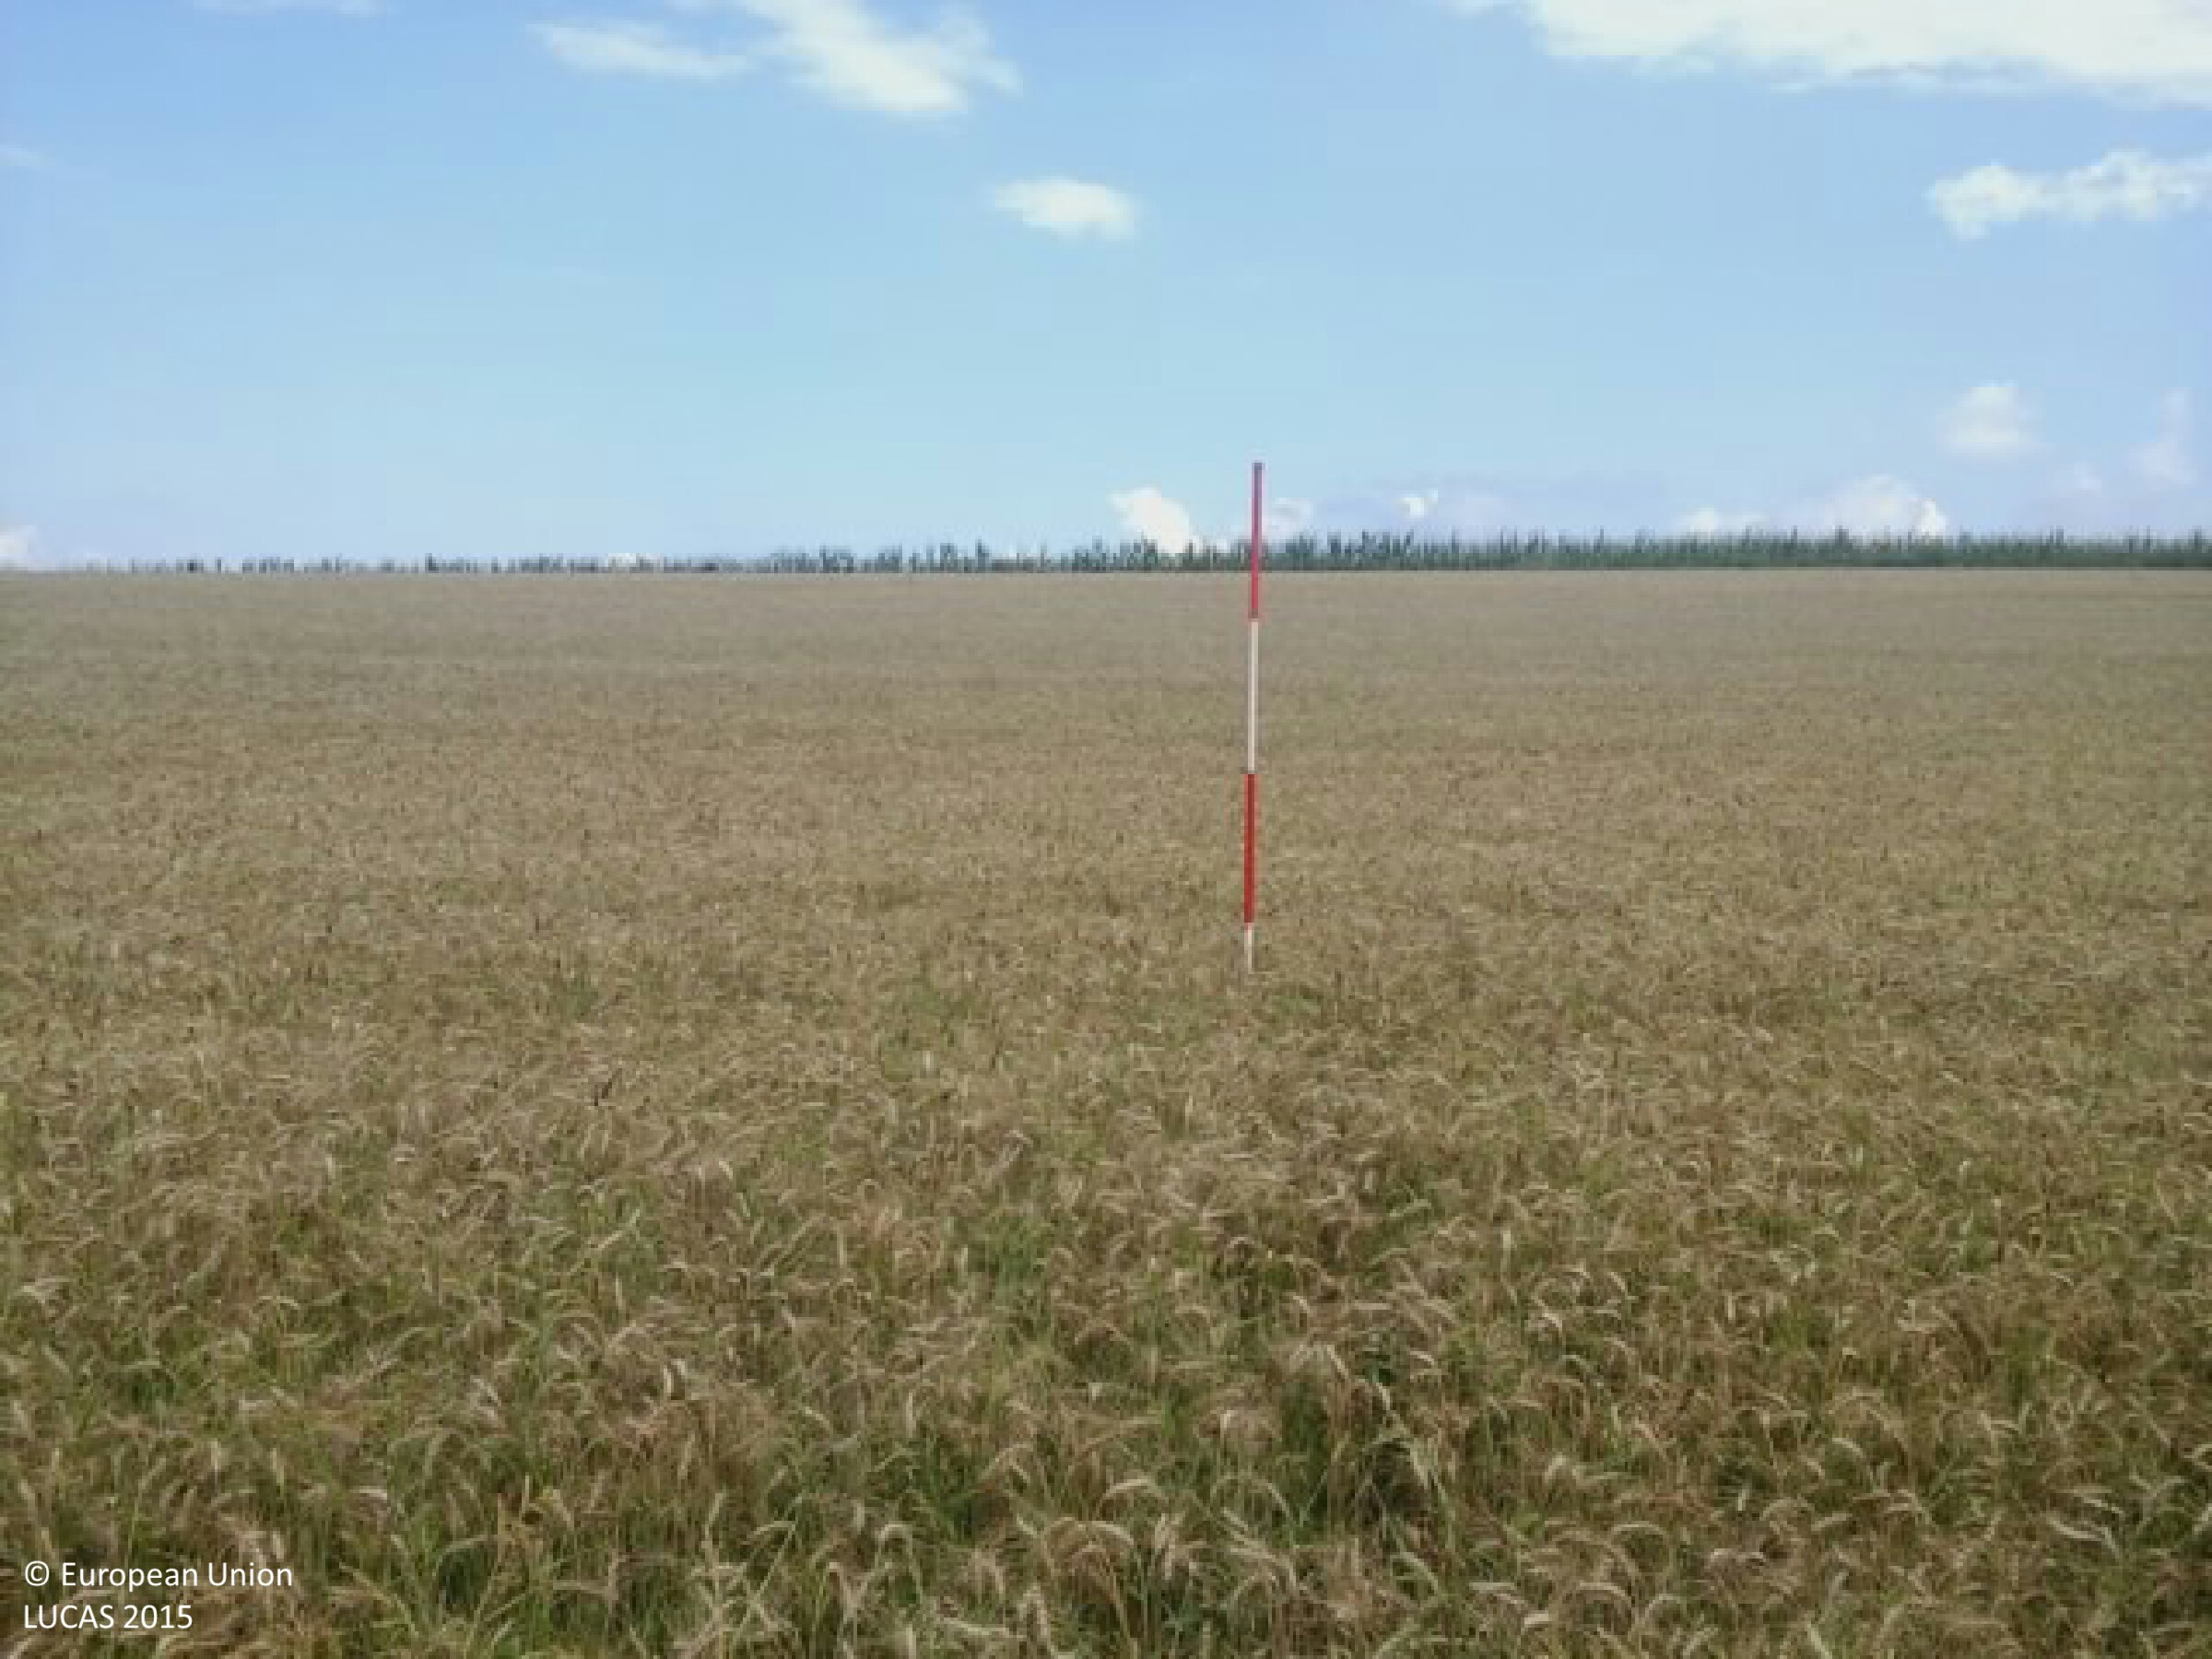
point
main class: Cropland
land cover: Triticale
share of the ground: > 75 %
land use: Agriculture (excluding fallow land and kitchen gardens)
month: August
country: HU
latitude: 46.2001
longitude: 18.1846
